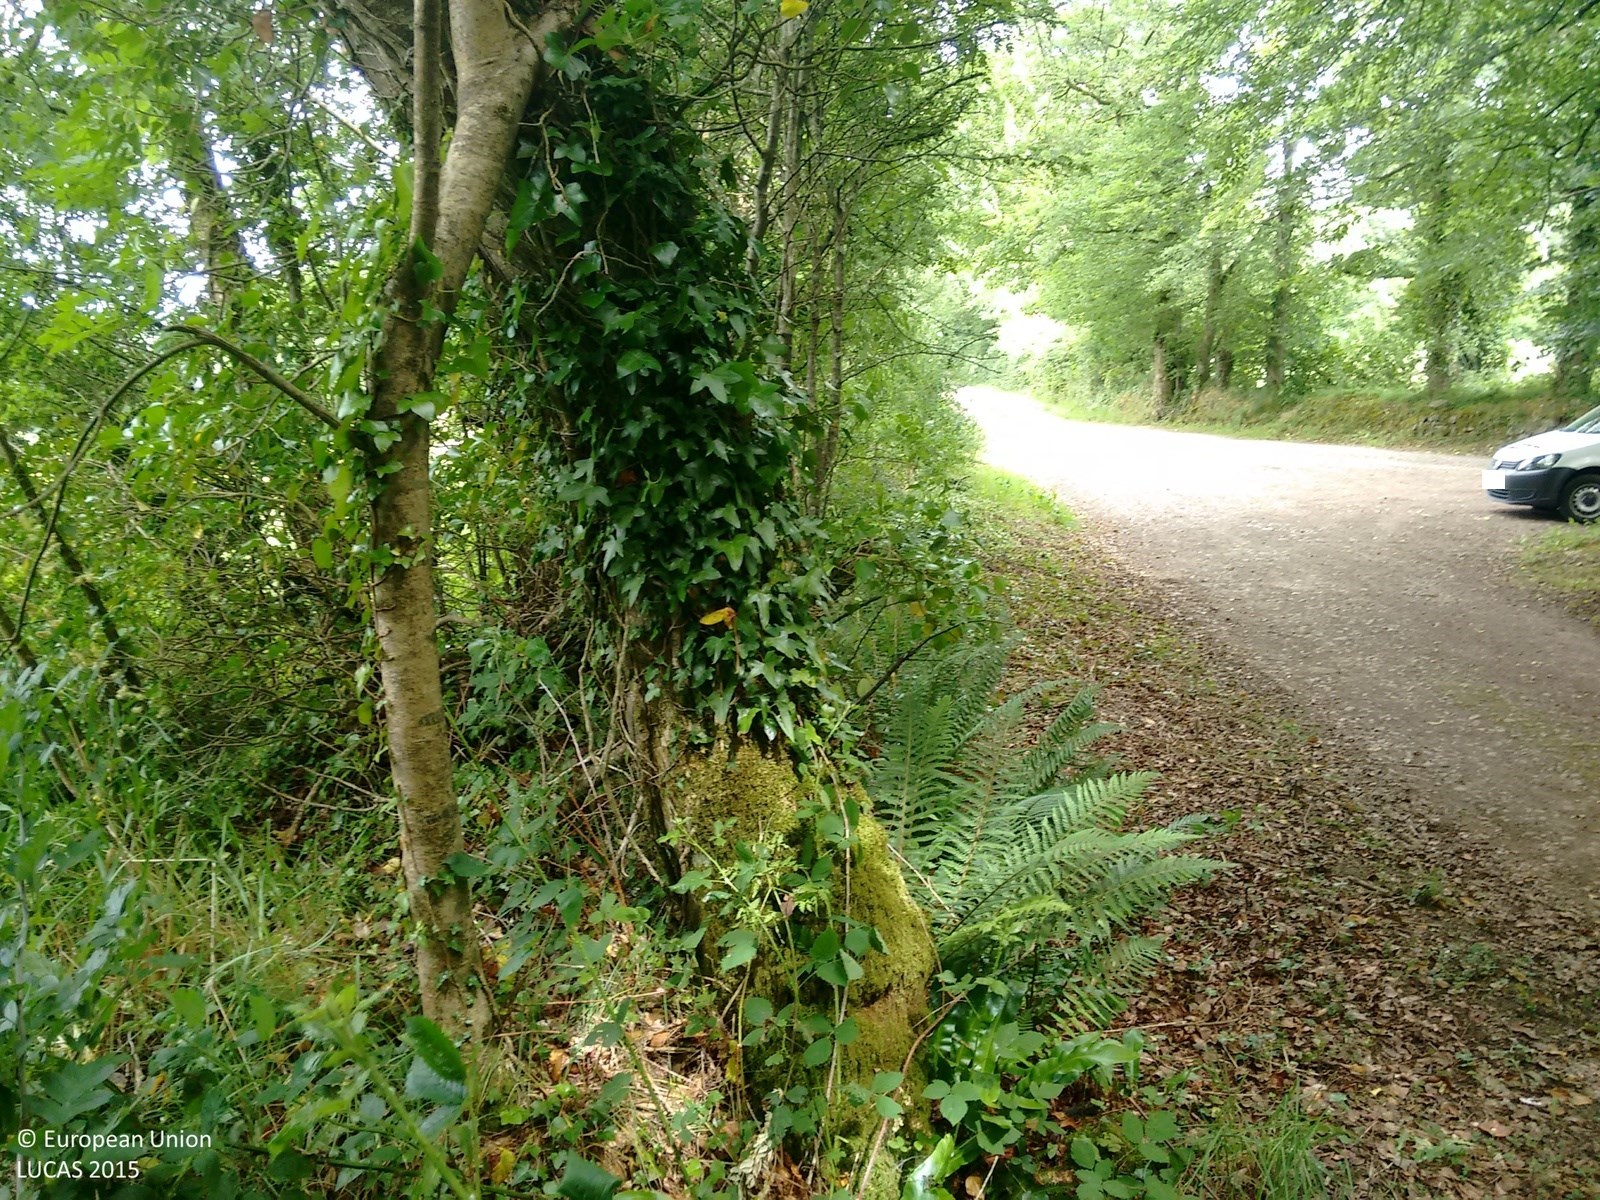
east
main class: Cropland
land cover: Oats
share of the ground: > 75 %
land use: Agriculture (excluding fallow land and kitchen gardens)
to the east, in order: Oats; Broadleaved woodland; Ditches and canals; Broadleaved woodland; Grassland without tree/shrub cover; Electric lines; Grassland without tree/shrub cover; Broadleaved woodland; Grassland without tree/shrub cover
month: July
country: IE
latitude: 52.1685
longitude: -8.9097
